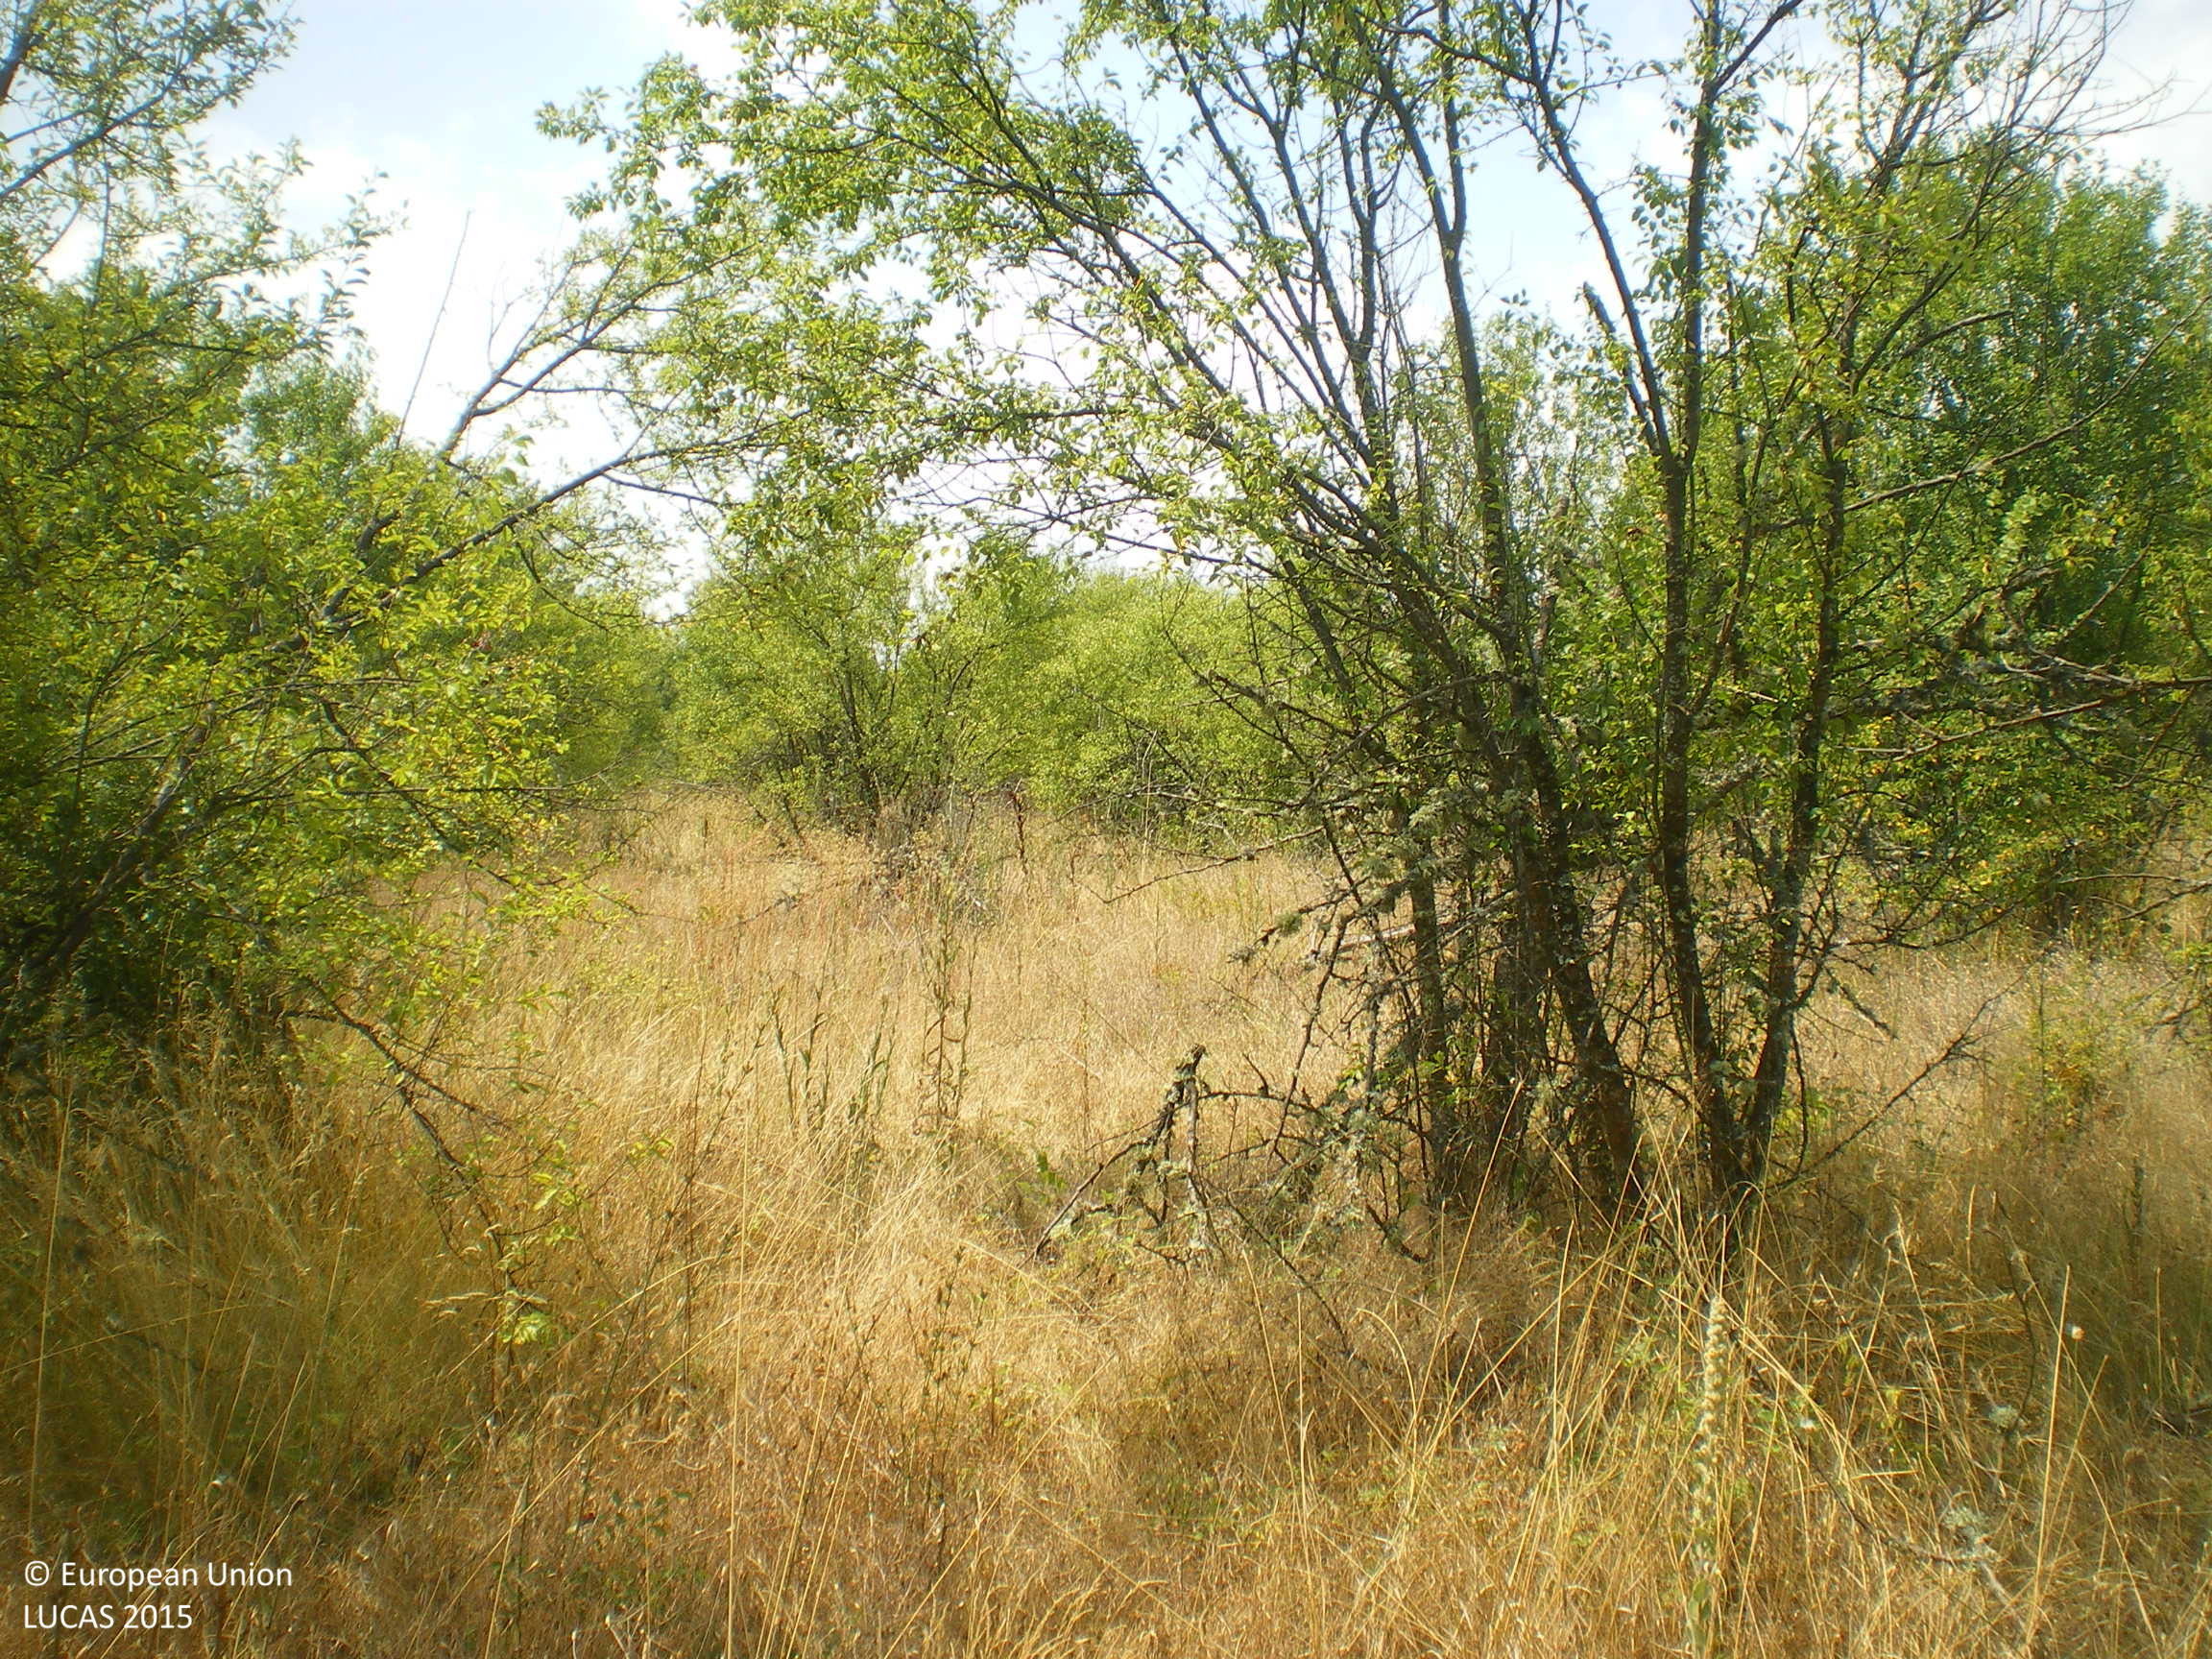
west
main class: Cropland
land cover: Other fruit trees and berries
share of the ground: 50 - 75 %
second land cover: Grassland without tree/shrub cover
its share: 25 - 50 %
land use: Abandoned areas
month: August
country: BG
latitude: 42.3845
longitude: 25.4075
